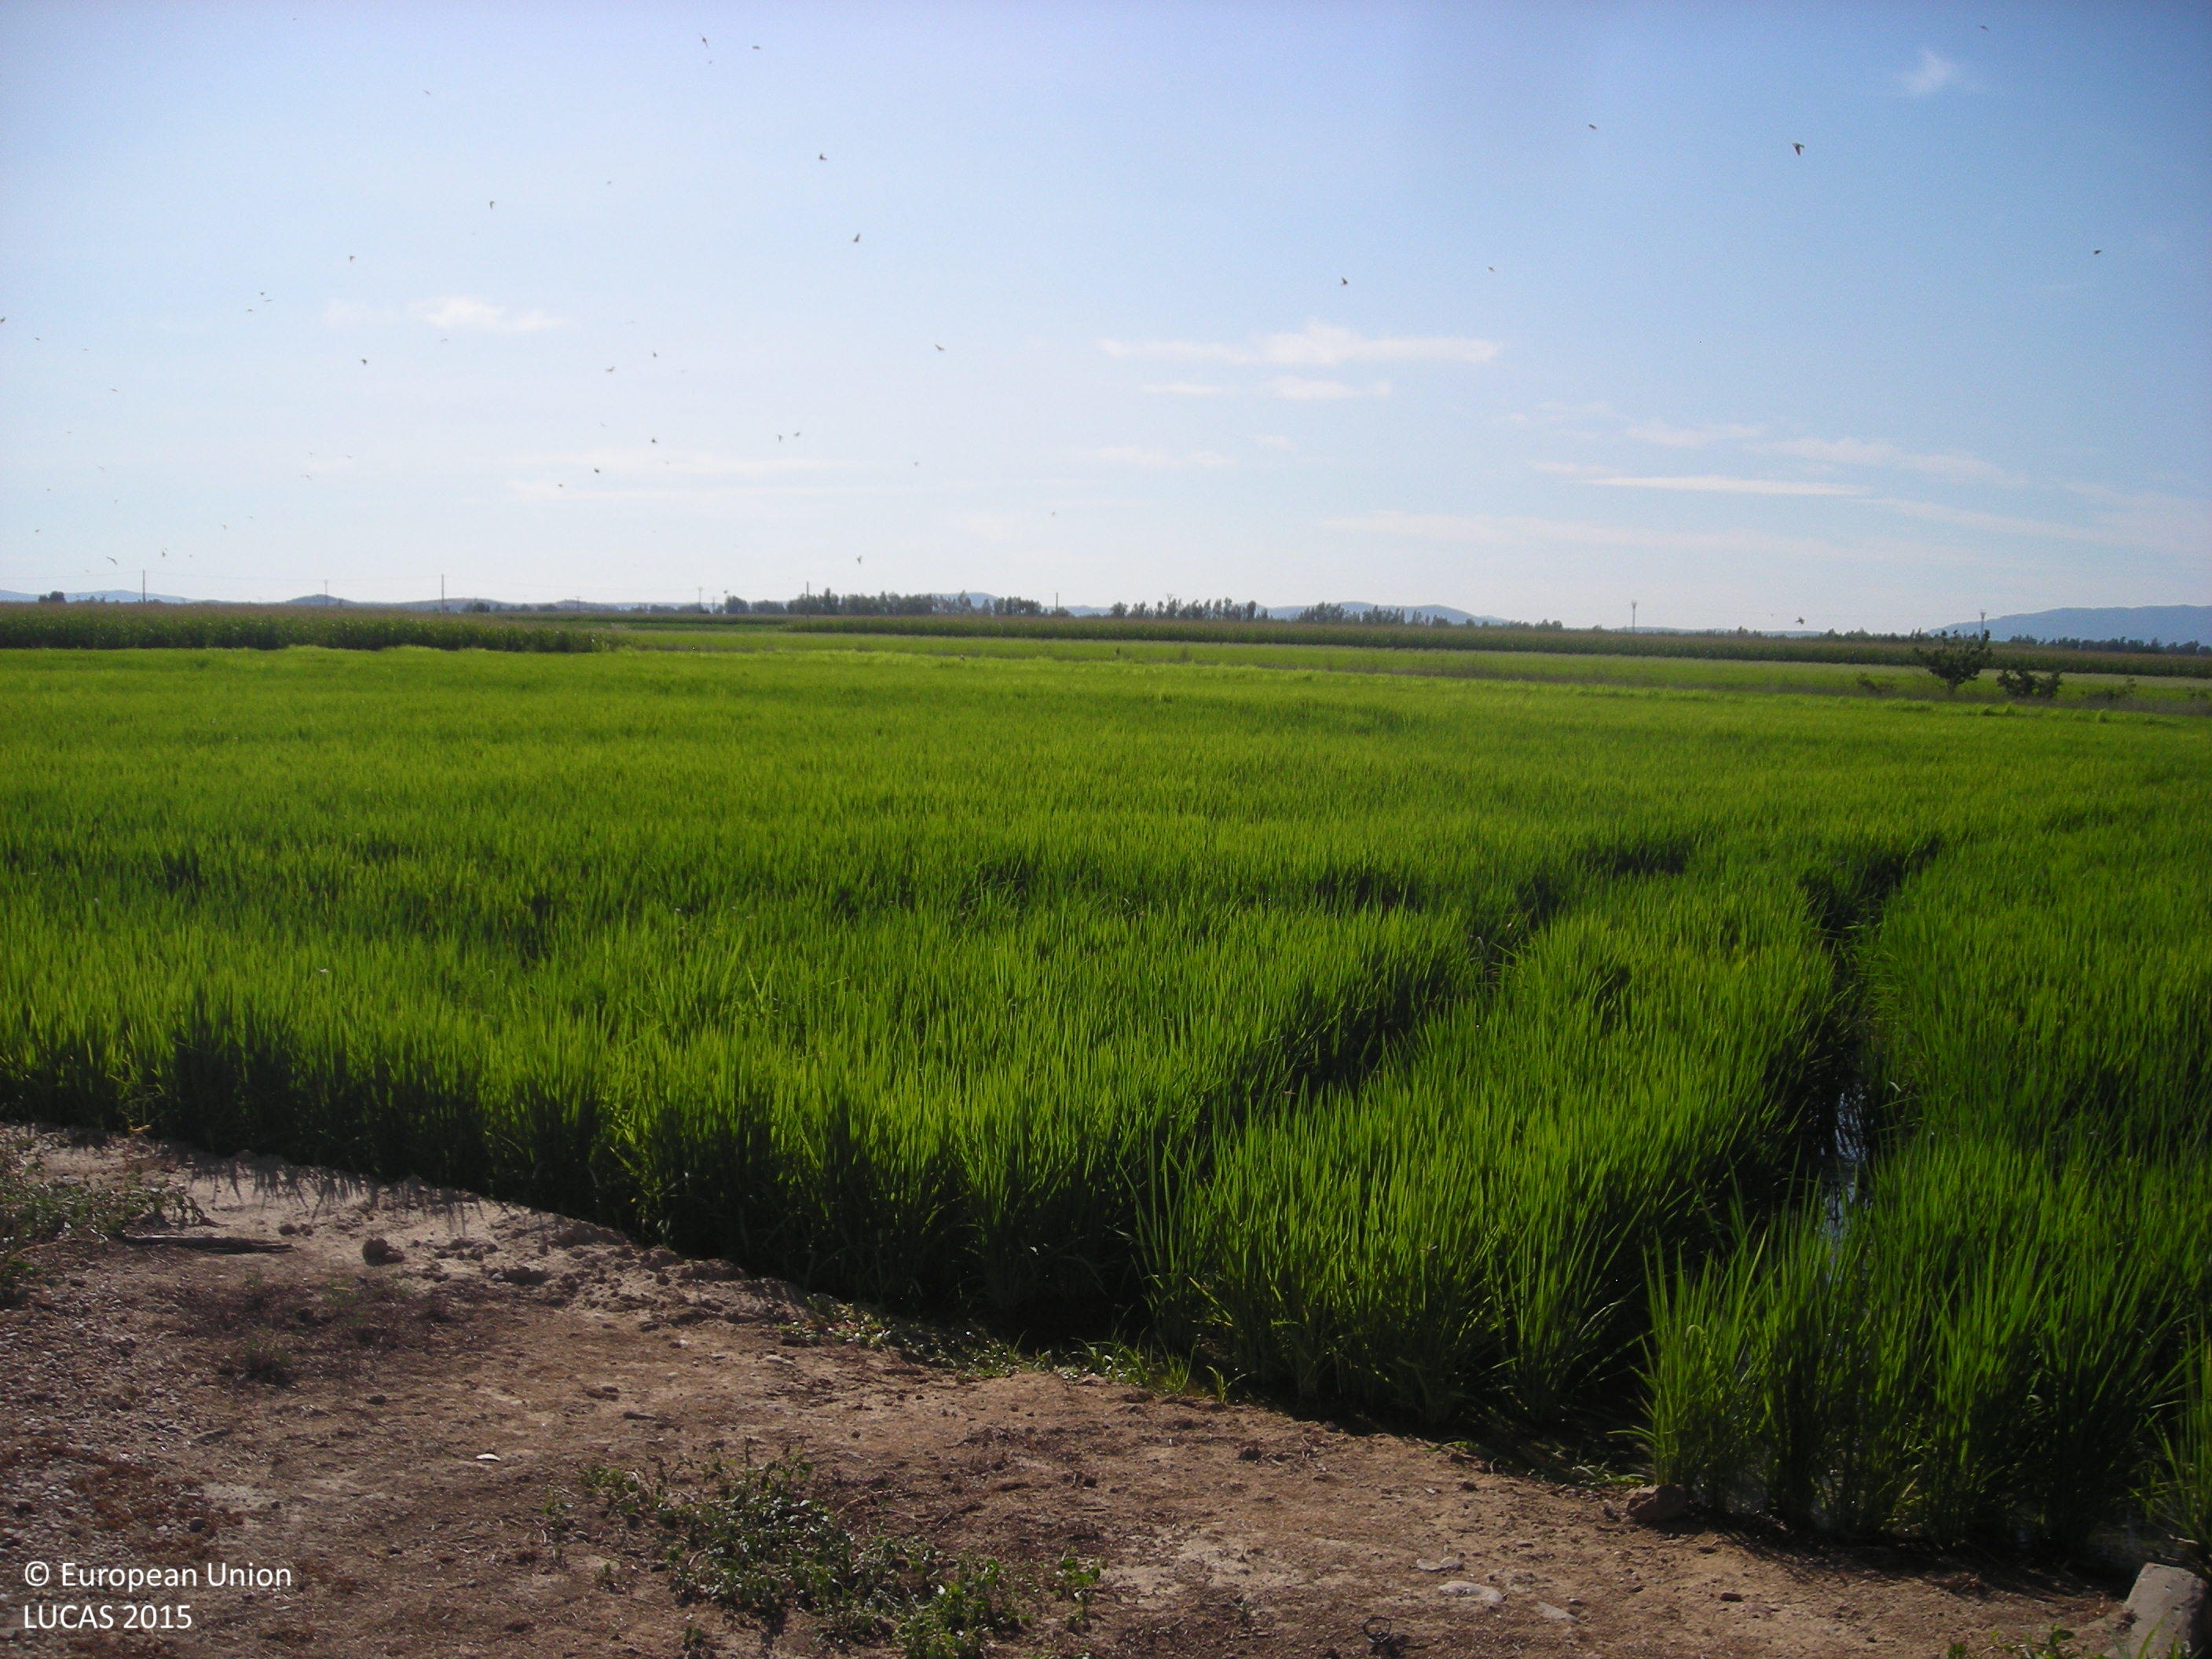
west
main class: Cropland
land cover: Rice
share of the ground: > 75 %
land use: Agriculture (excluding fallow land and kitchen gardens)
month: July
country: ES
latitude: 39.0189
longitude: -5.8856
